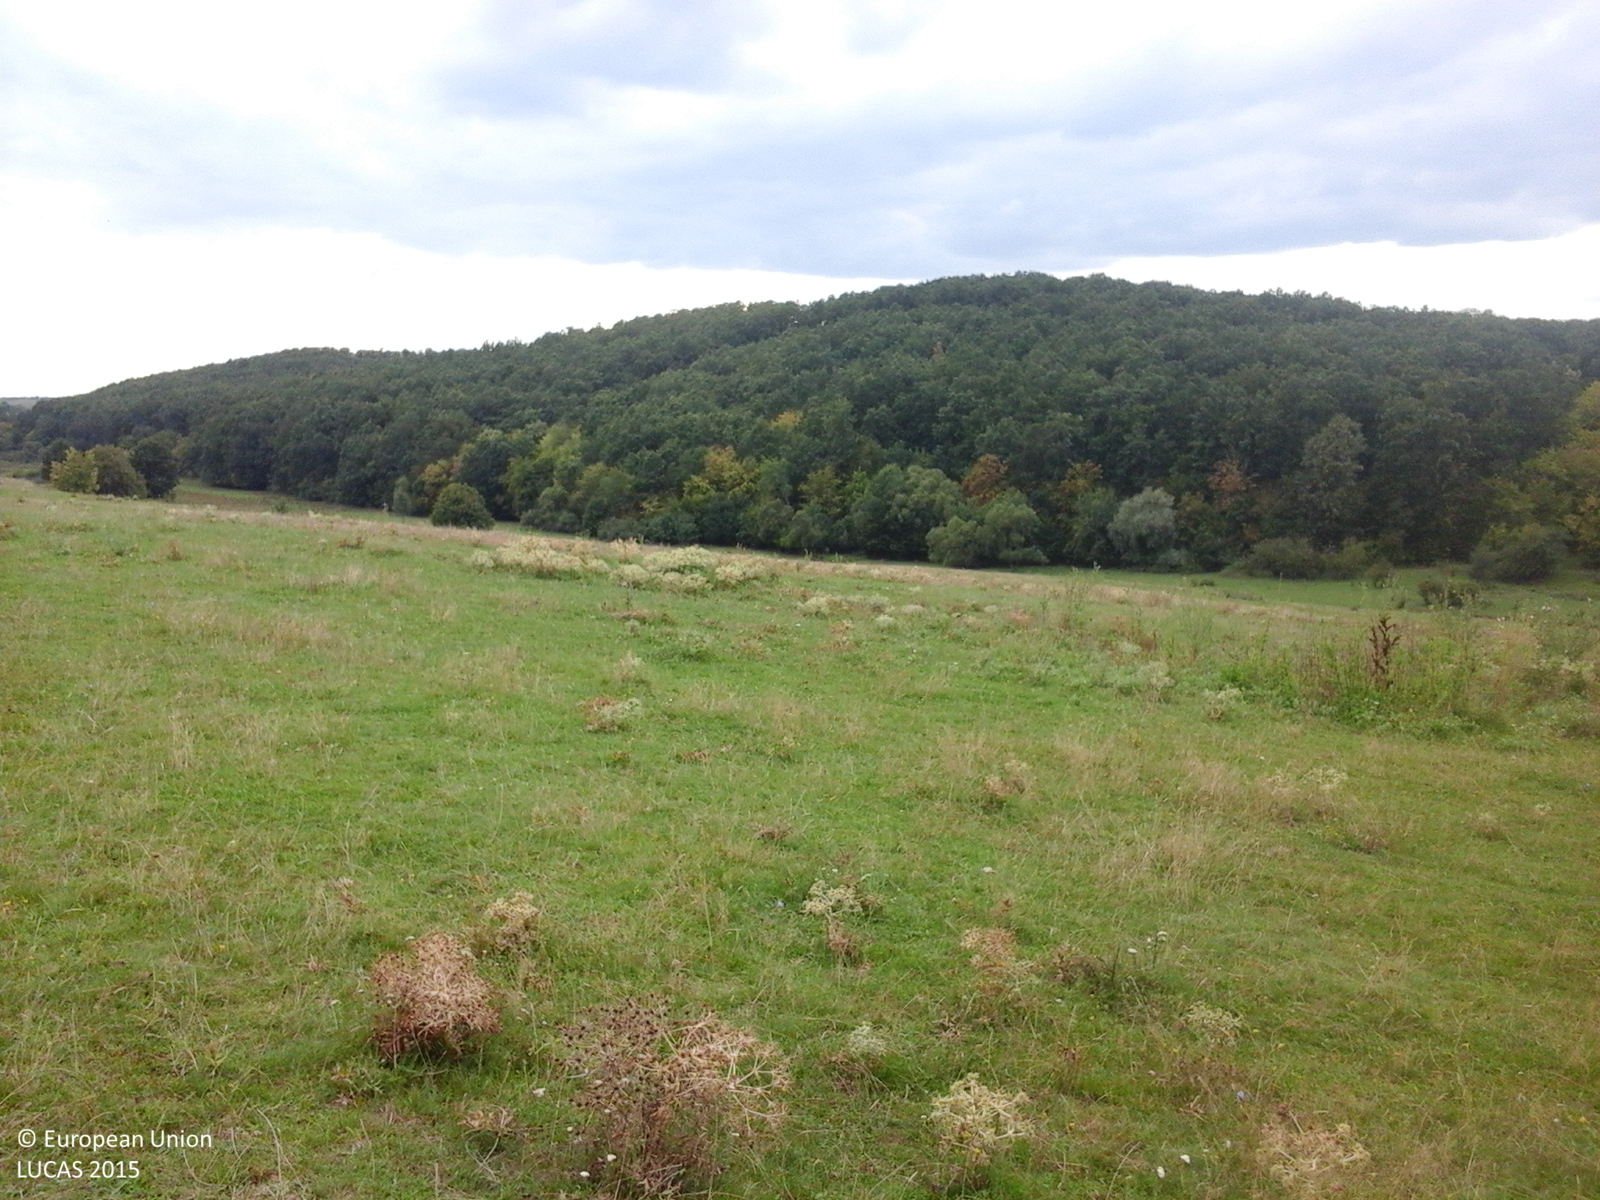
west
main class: Grassland
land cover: Grassland without tree/shrub cover
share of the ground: > 75 %
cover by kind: herbaceous plants 100 %
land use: Agriculture (excluding fallow land and kitchen gardens)
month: September
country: RO
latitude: 47.4345
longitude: 22.6684
